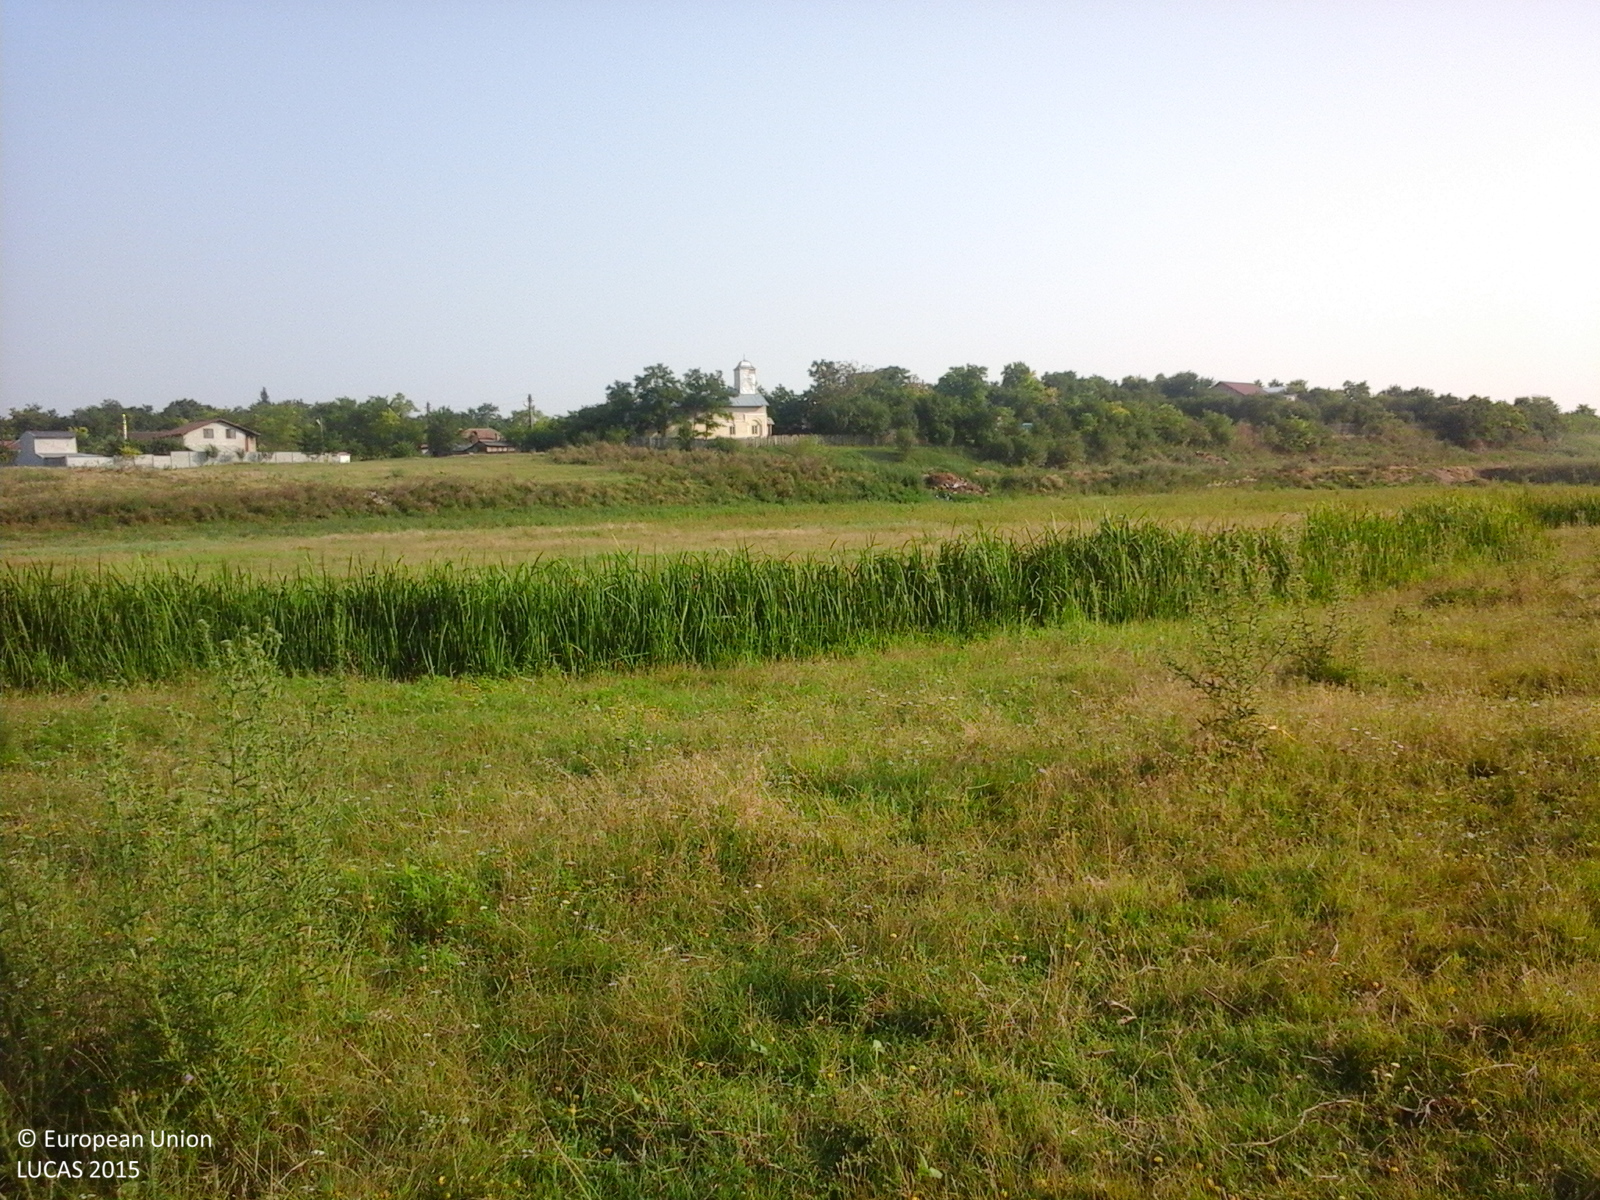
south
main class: Grassland
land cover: Spontaneously vegetated surfaces
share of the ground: > 75 %
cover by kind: herbaceous plants 100 %
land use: Fallow land
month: July
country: RO
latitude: 44.4594
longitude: 26.5689
